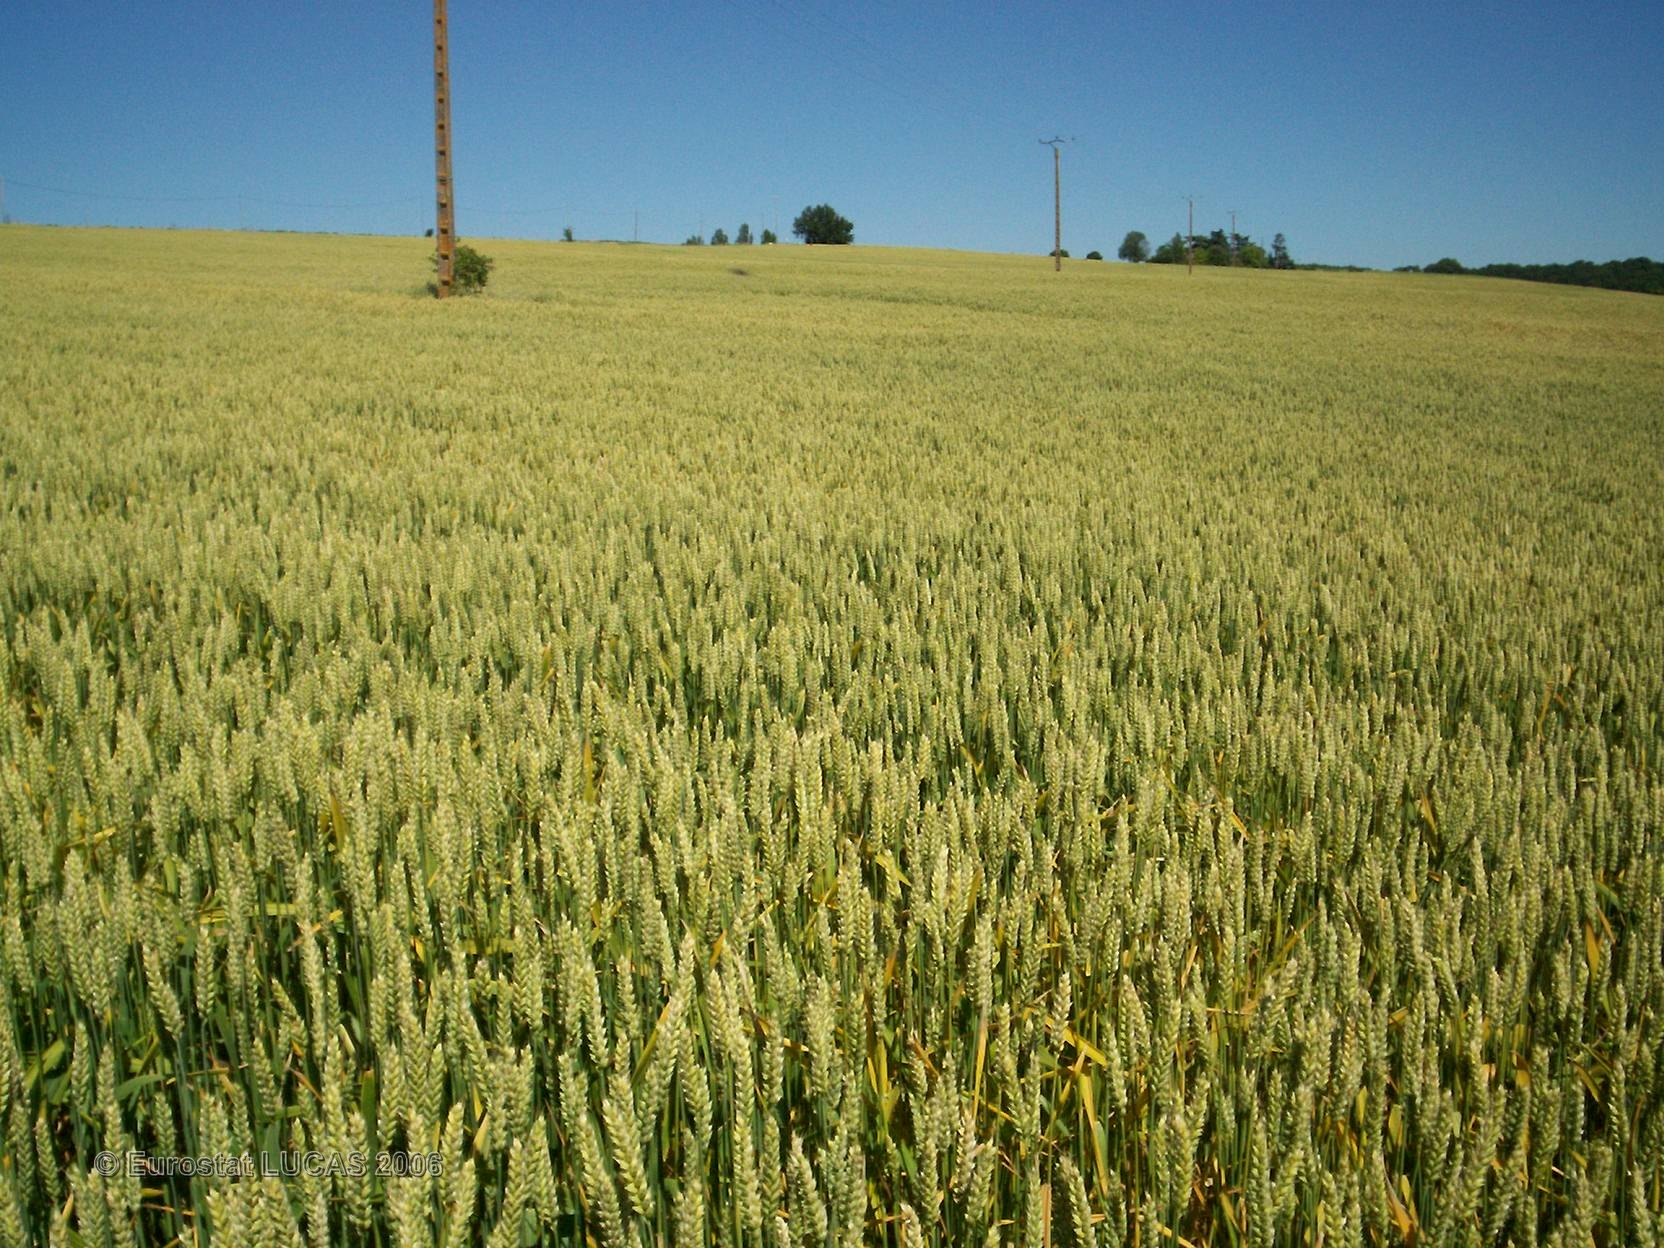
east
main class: Cropland
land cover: Common wheat
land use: Agriculture (excluding fallow land and kitchen gardens)
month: June
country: FR
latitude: 43.9067
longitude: 0.8209
